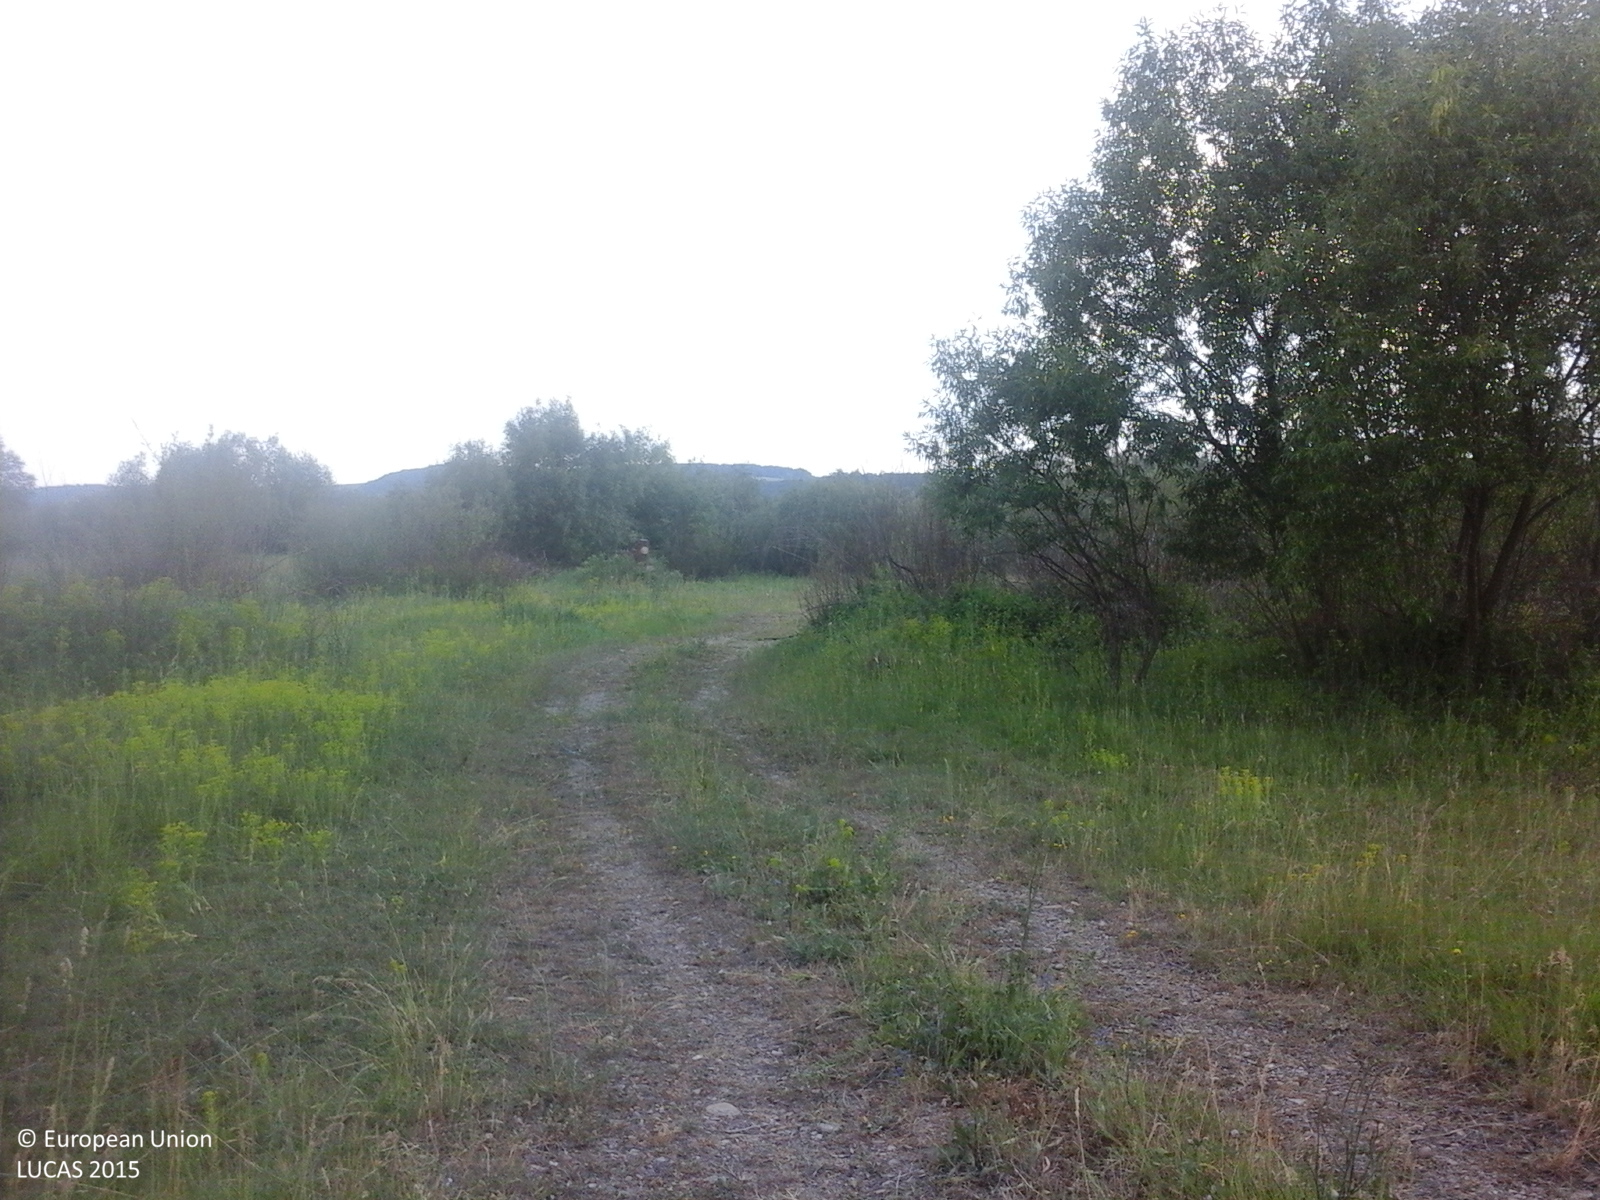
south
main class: Grassland
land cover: Grassland with sparse tree/shrub cover
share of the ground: > 75 %
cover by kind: herbaceous plants 90 %, broadleaved forest trees 5 %, shrubs 5 %
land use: Agriculture (excluding fallow land and kitchen gardens)
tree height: < 5 m
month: June
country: RO
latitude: 46.4791
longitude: 26.6944
